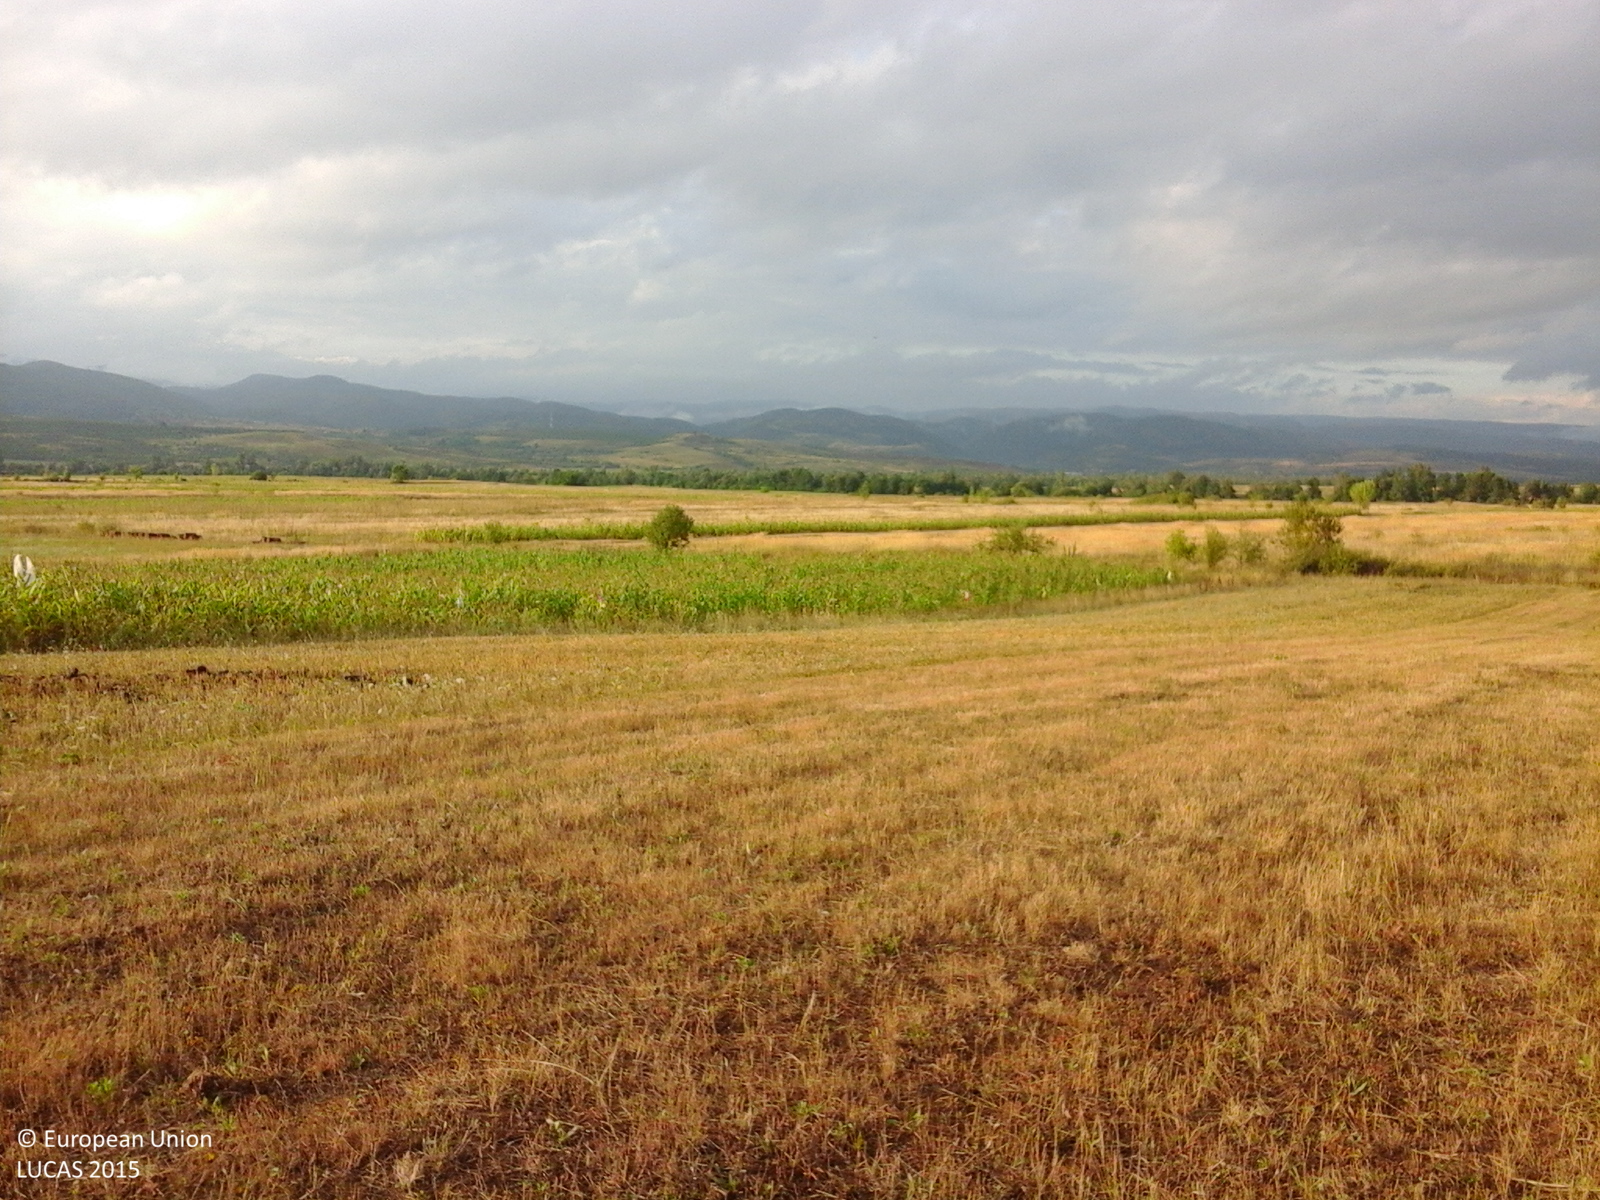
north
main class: Grassland
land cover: Grassland without tree/shrub cover
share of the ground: > 75 %
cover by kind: herbaceous plants 100 %
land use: Agriculture (excluding fallow land and kitchen gardens)
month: August
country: RO
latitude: 44.8752
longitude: 21.9709
